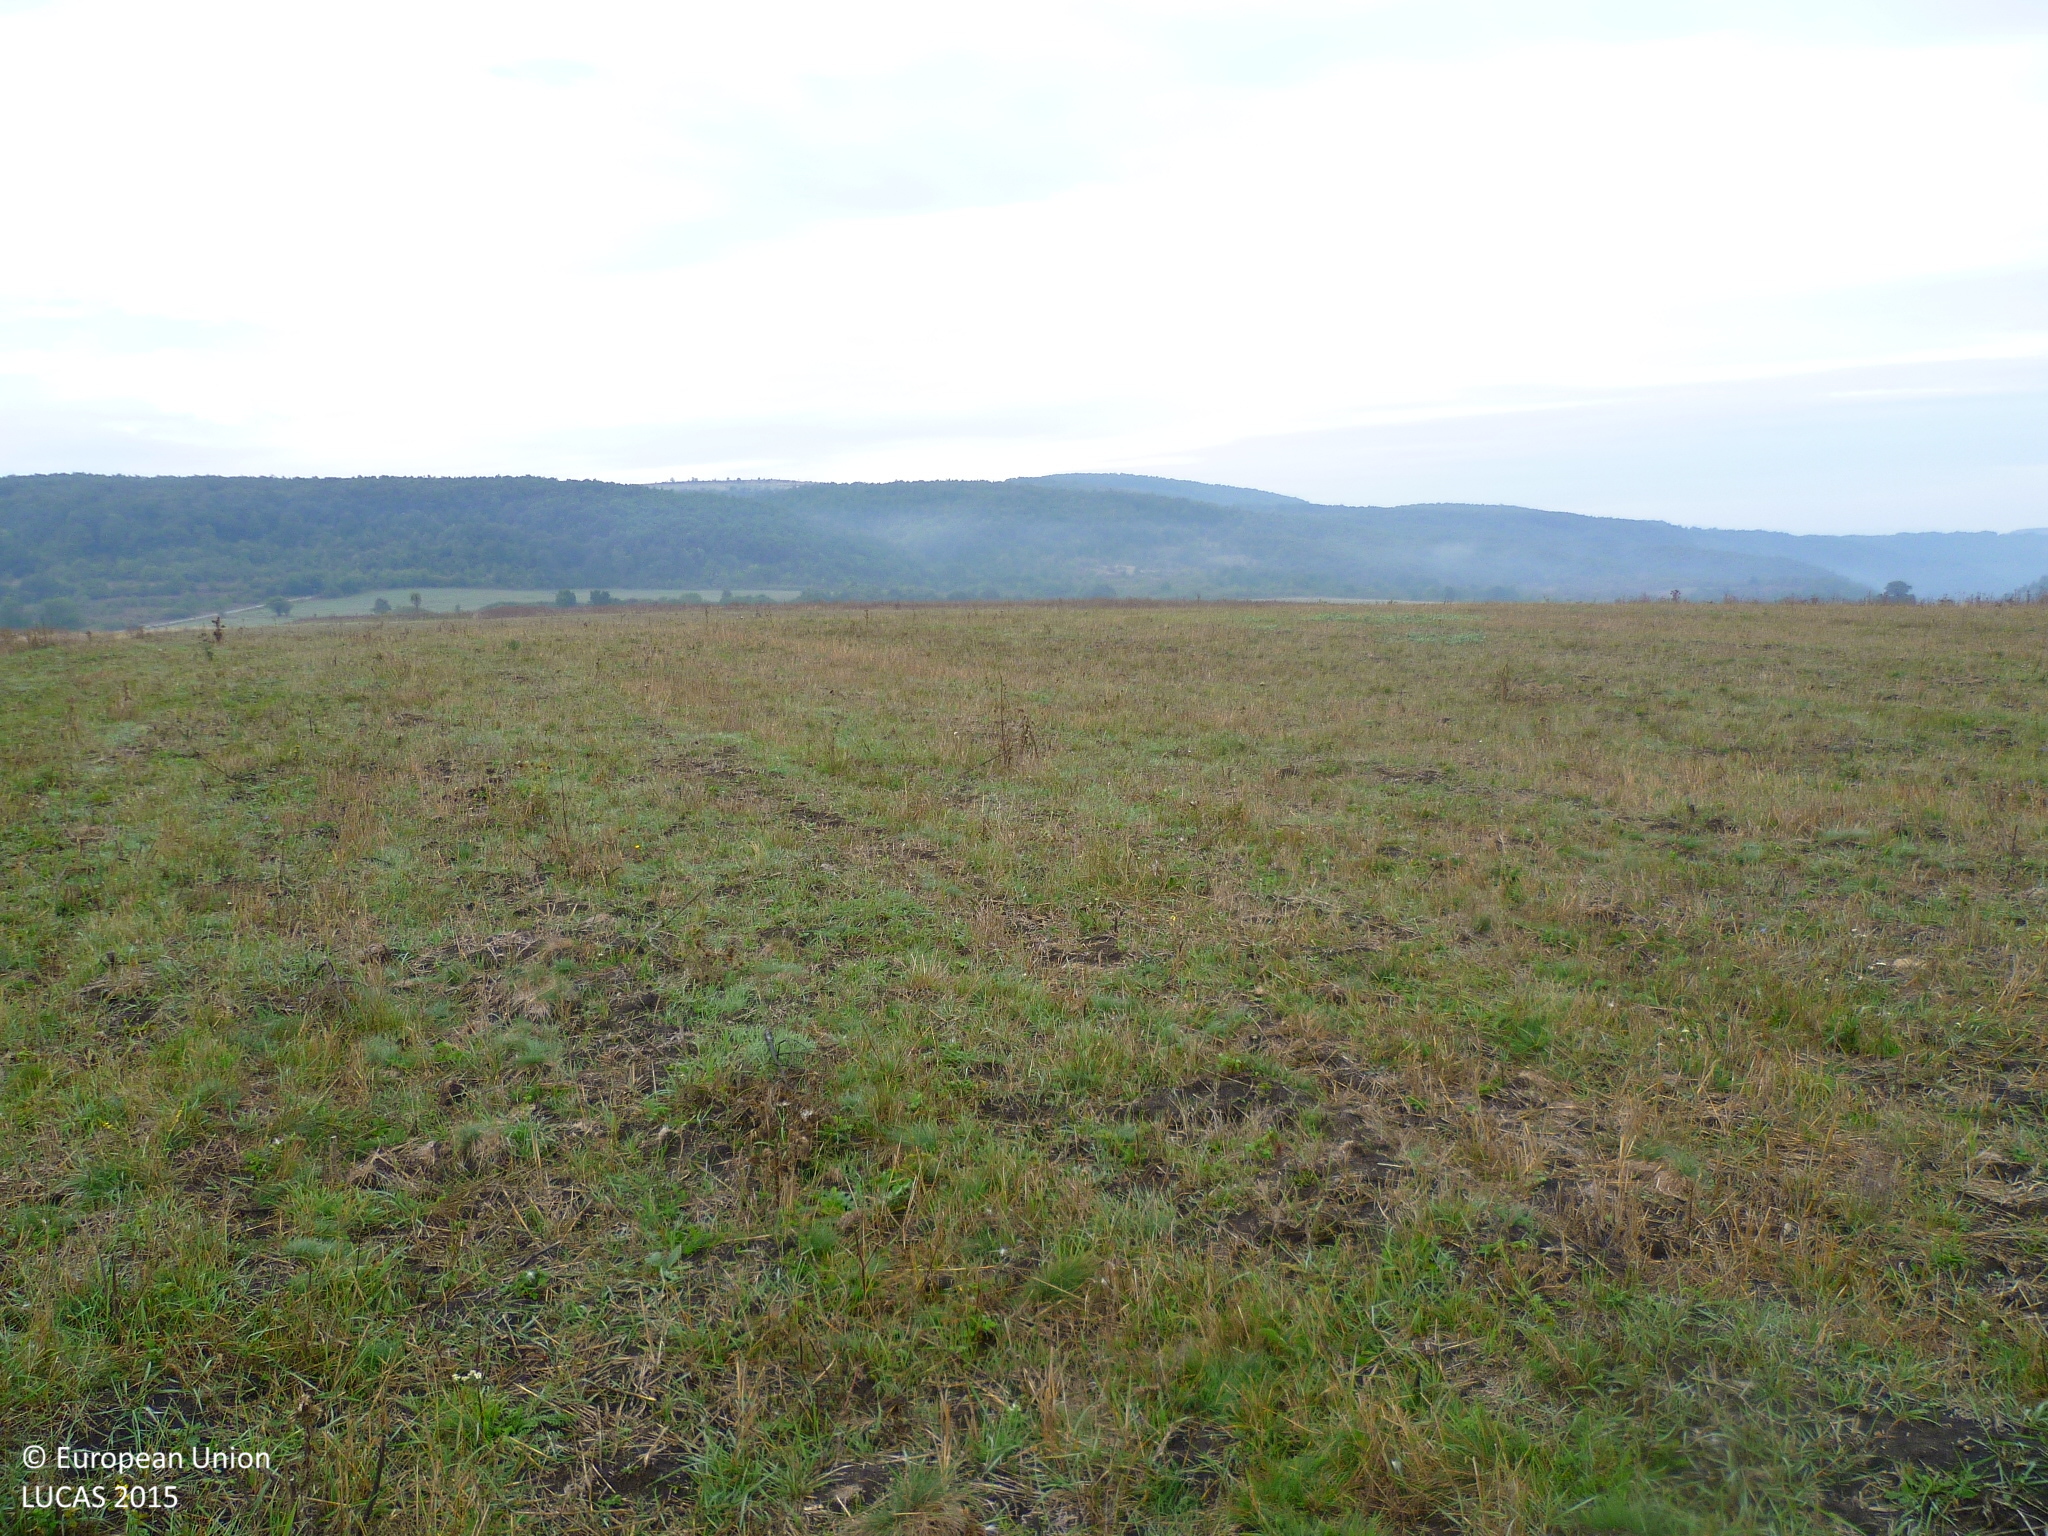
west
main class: Grassland
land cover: Grassland without tree/shrub cover
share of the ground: > 75 %
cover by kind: herbaceous plants 100 %
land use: Agriculture (excluding fallow land and kitchen gardens)
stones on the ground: < 10 %
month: October
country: BG
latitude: 42.9881
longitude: 22.9461
